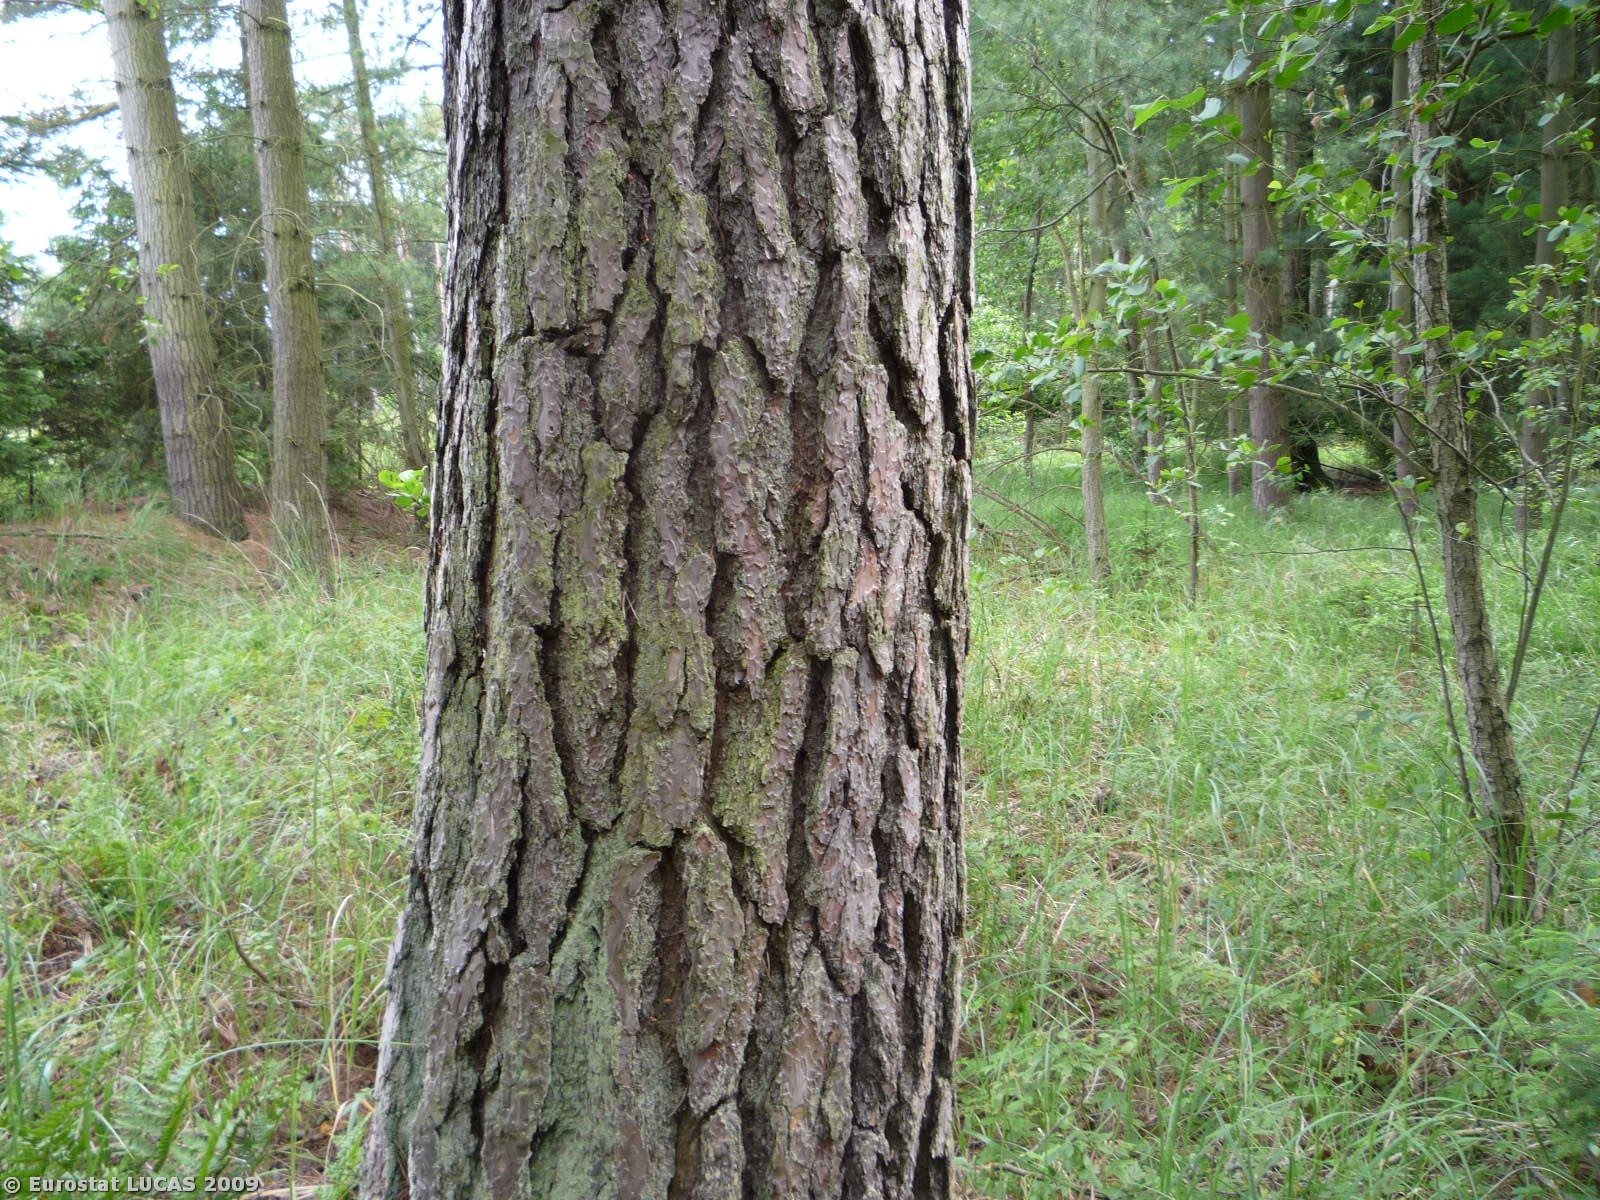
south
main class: Woodland
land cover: Coniferous woodland
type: hemiboreal forest and nemoral coniferous forest and mixed broadleaved-coniferous forest
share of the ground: > 75 %
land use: Forestry
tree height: > 5 m
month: June
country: CZ
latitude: 50.0685
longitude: 15.5227
